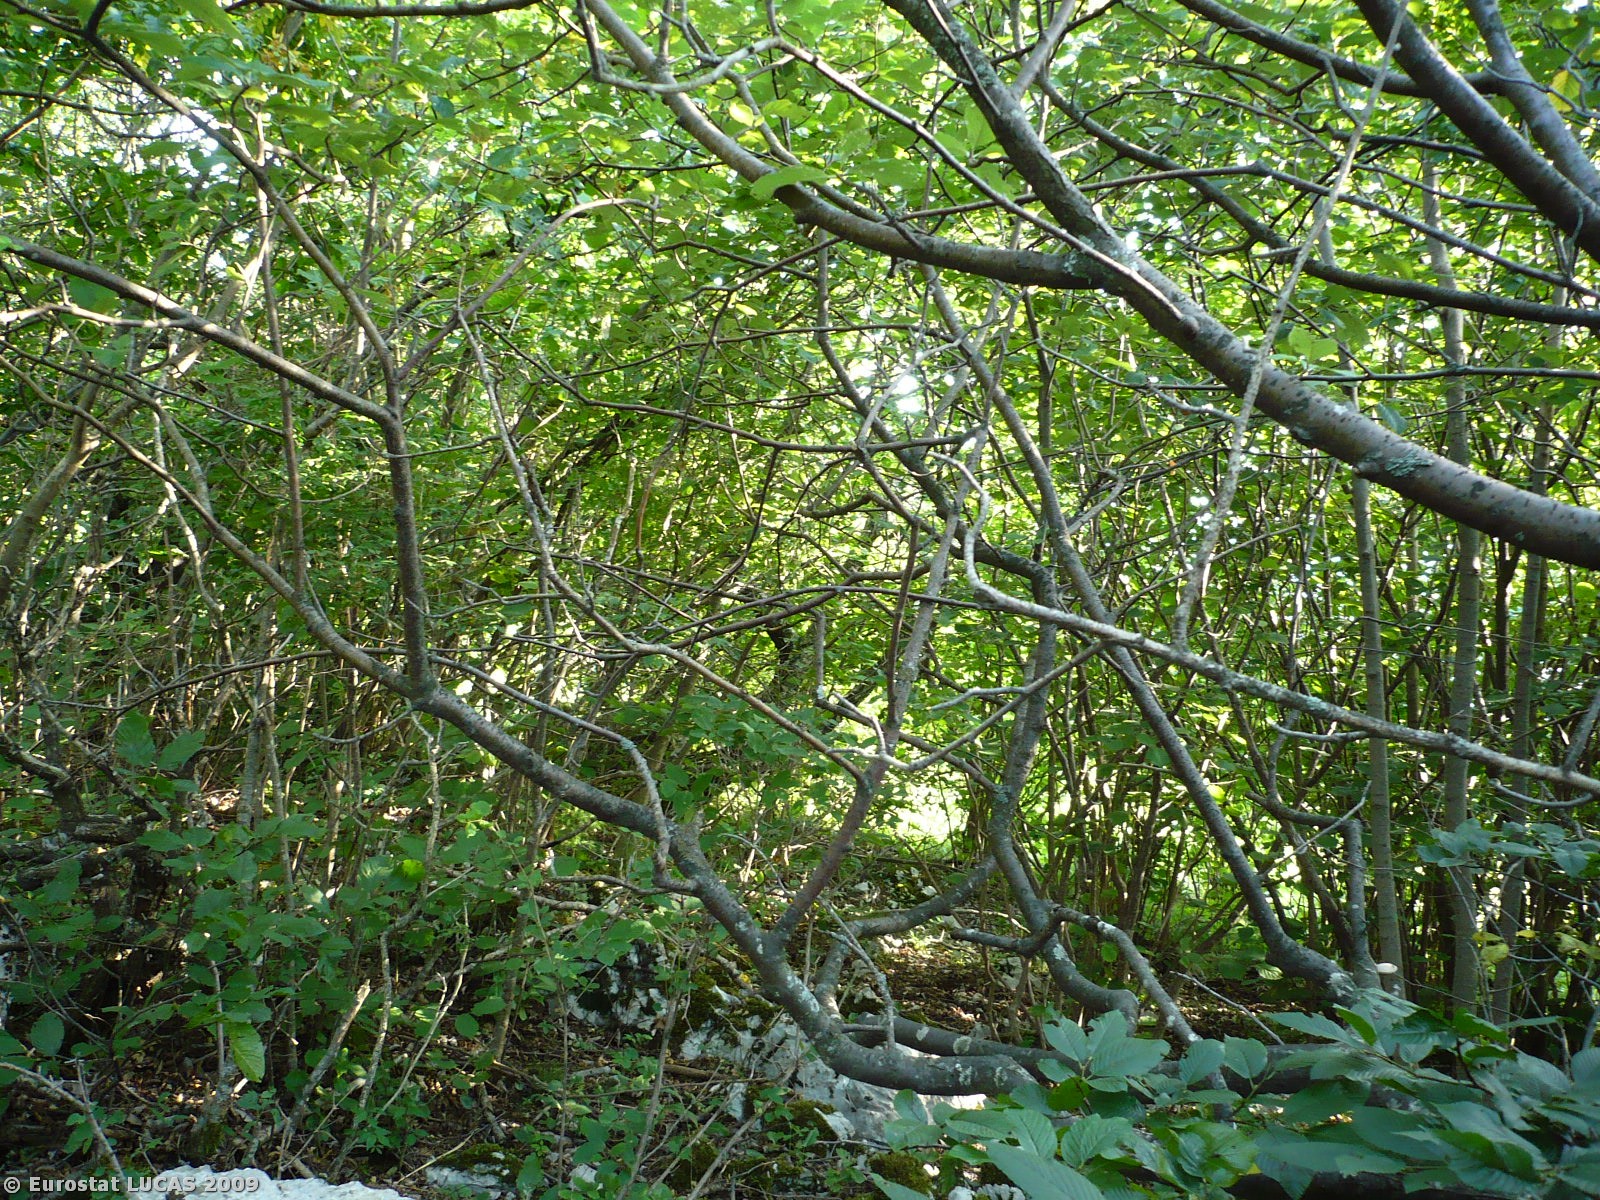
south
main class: Woodland
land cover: Broadleaved woodland
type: thermophilous deciduous forest
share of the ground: > 75 %
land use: Unused
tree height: > 5 m
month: July
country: SI
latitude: 45.5607
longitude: 14.3129
